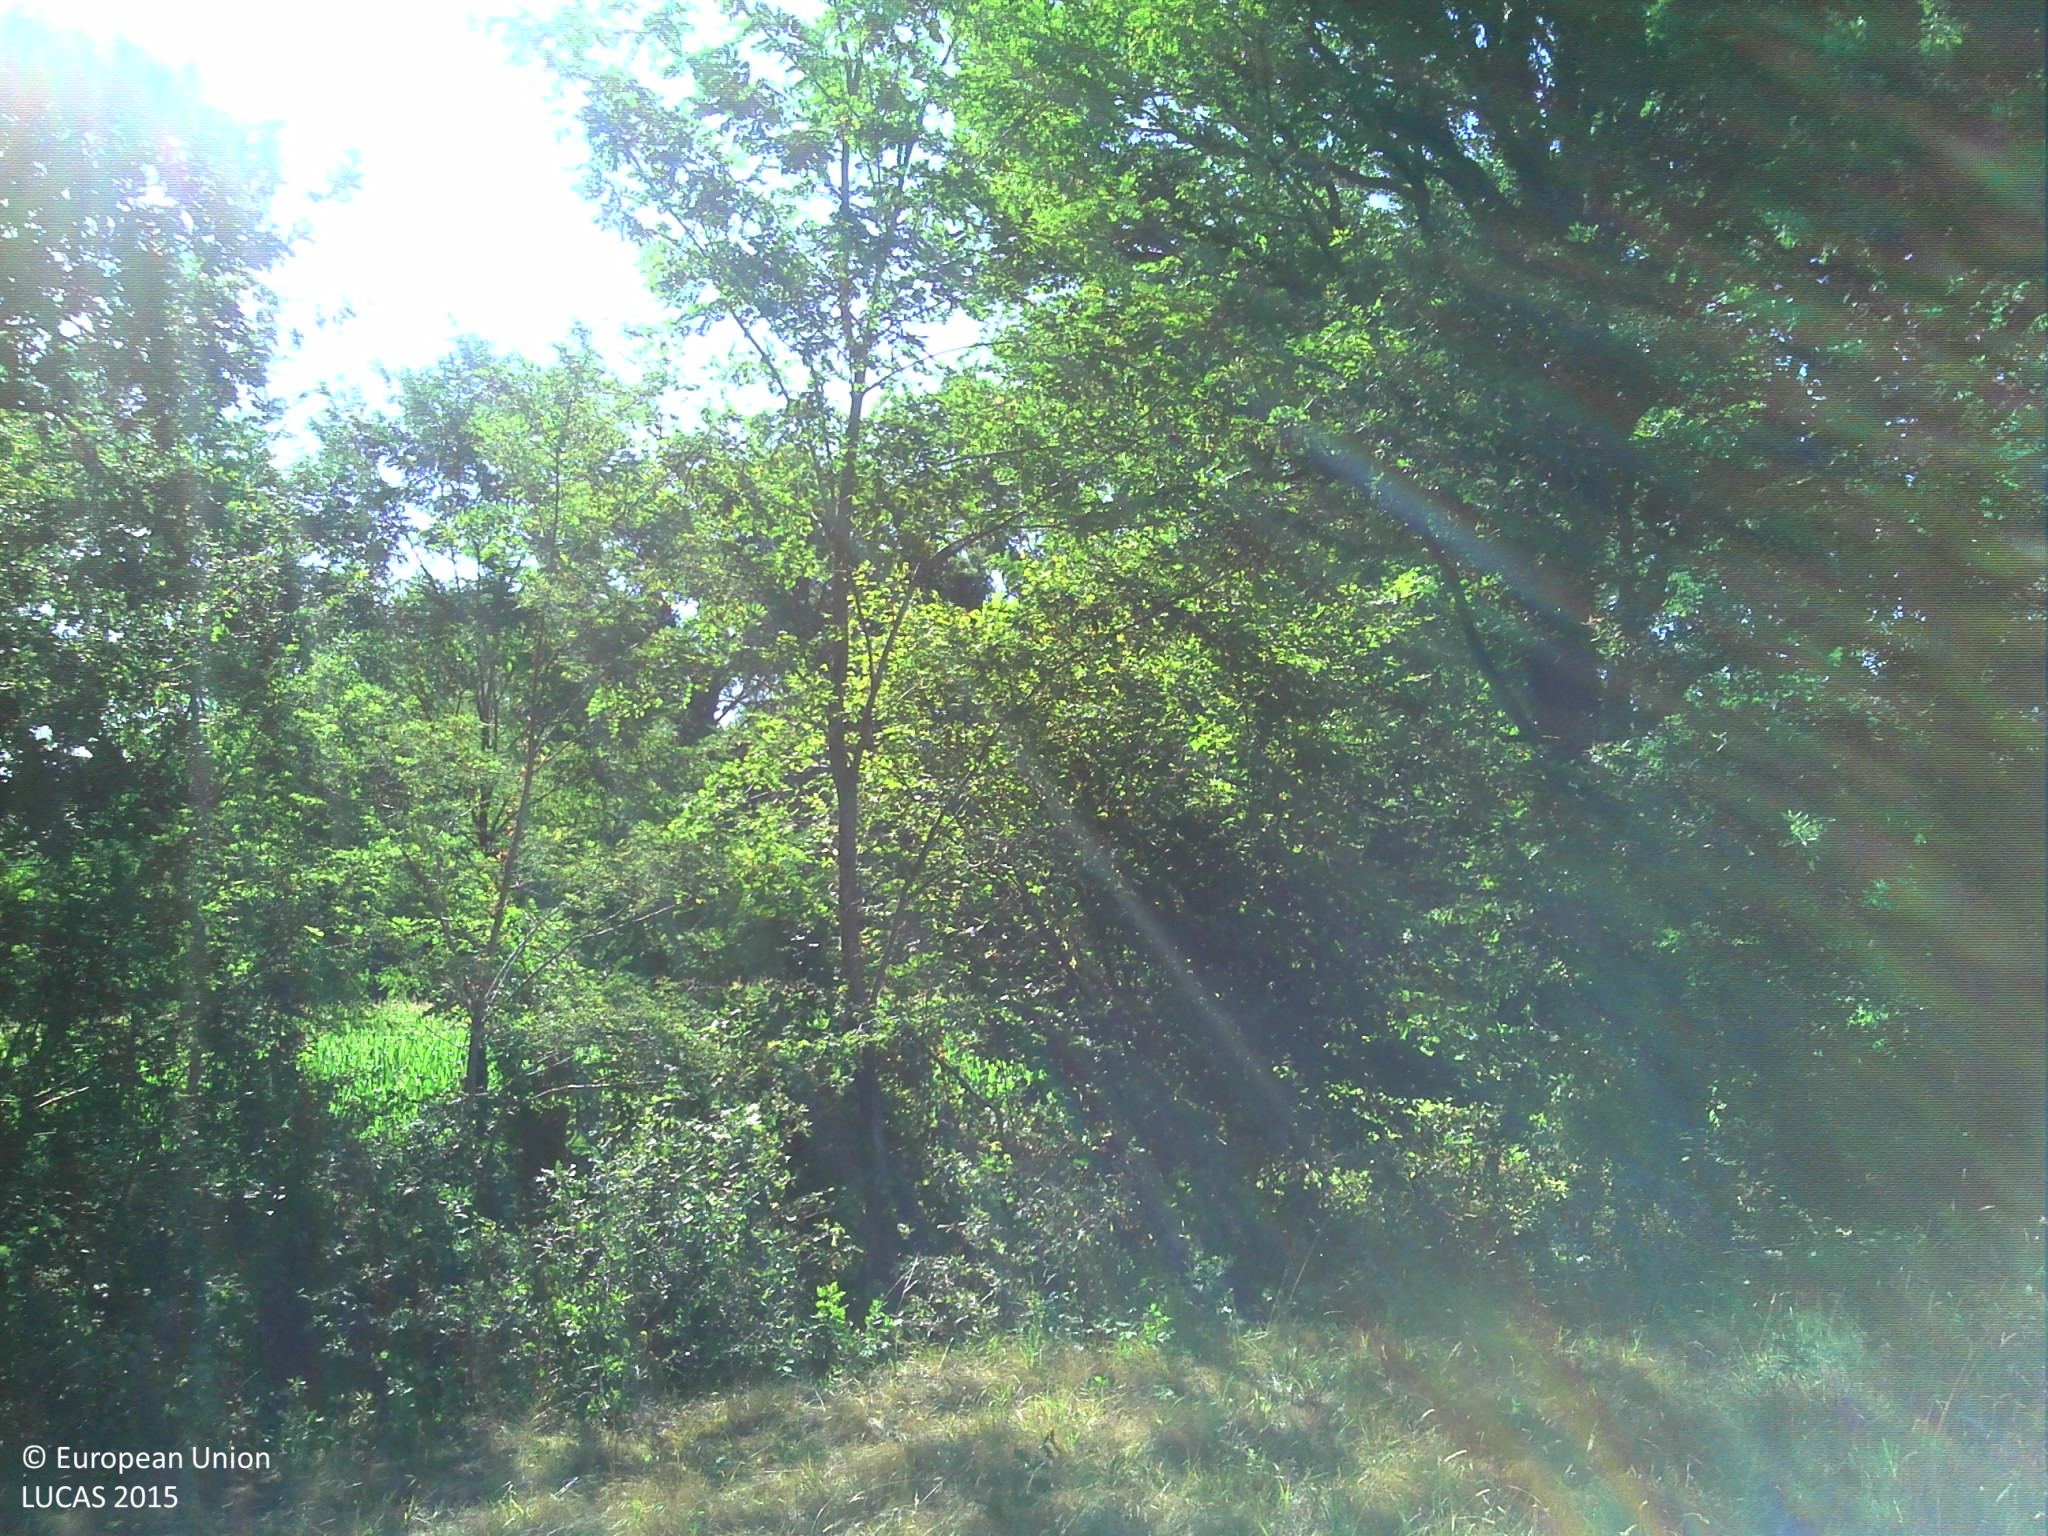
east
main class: Grassland
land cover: Grassland without tree/shrub cover
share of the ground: > 75 %
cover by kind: herbaceous plants 95 %, shrubs 5 %
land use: Agriculture (excluding fallow land and kitchen gardens)
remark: Temporary dry
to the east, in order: Grassland without tree/shrub cover; Abandoned hedges; Grass margins; Paved roads, cycling and walking lanes; Grass margins; Electric lines; Abandoned hedges; Maize; Broadleaved woodland; Maize; Broadleaved woodland
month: July
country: FR
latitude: 43.6428
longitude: -1.1108
